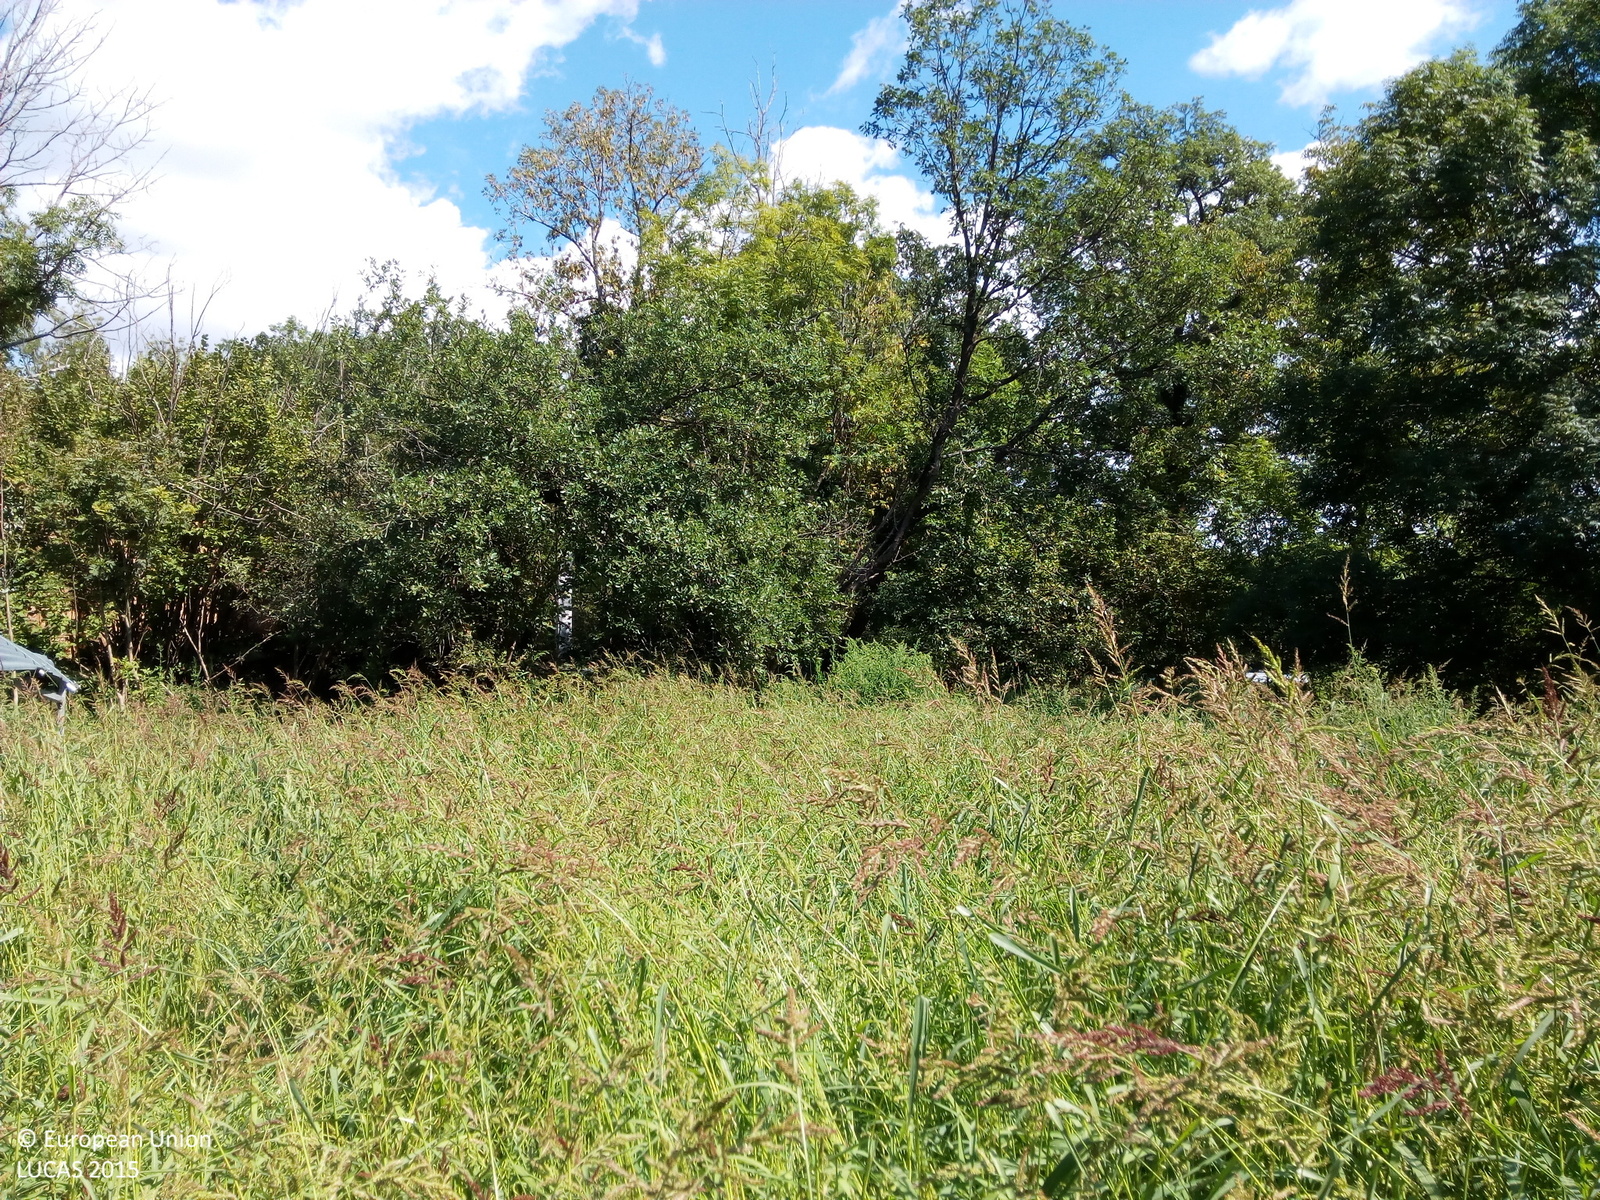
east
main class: Cropland
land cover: Other cereals
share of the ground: > 75 %
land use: Agriculture (excluding fallow land and kitchen gardens)
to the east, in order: Other cereals; Broadleaved woodland; Dry stone walls; Tracks; Shruby margins; Fences; Other root crops; Shruby margins; Dry stone walls; Grassland without tree/shrub cover; Broadleaved woodland; Grassland with sparse tree/shrub cover; Broadleaved woodland
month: September
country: ES
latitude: 42.5154
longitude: 0.4986
